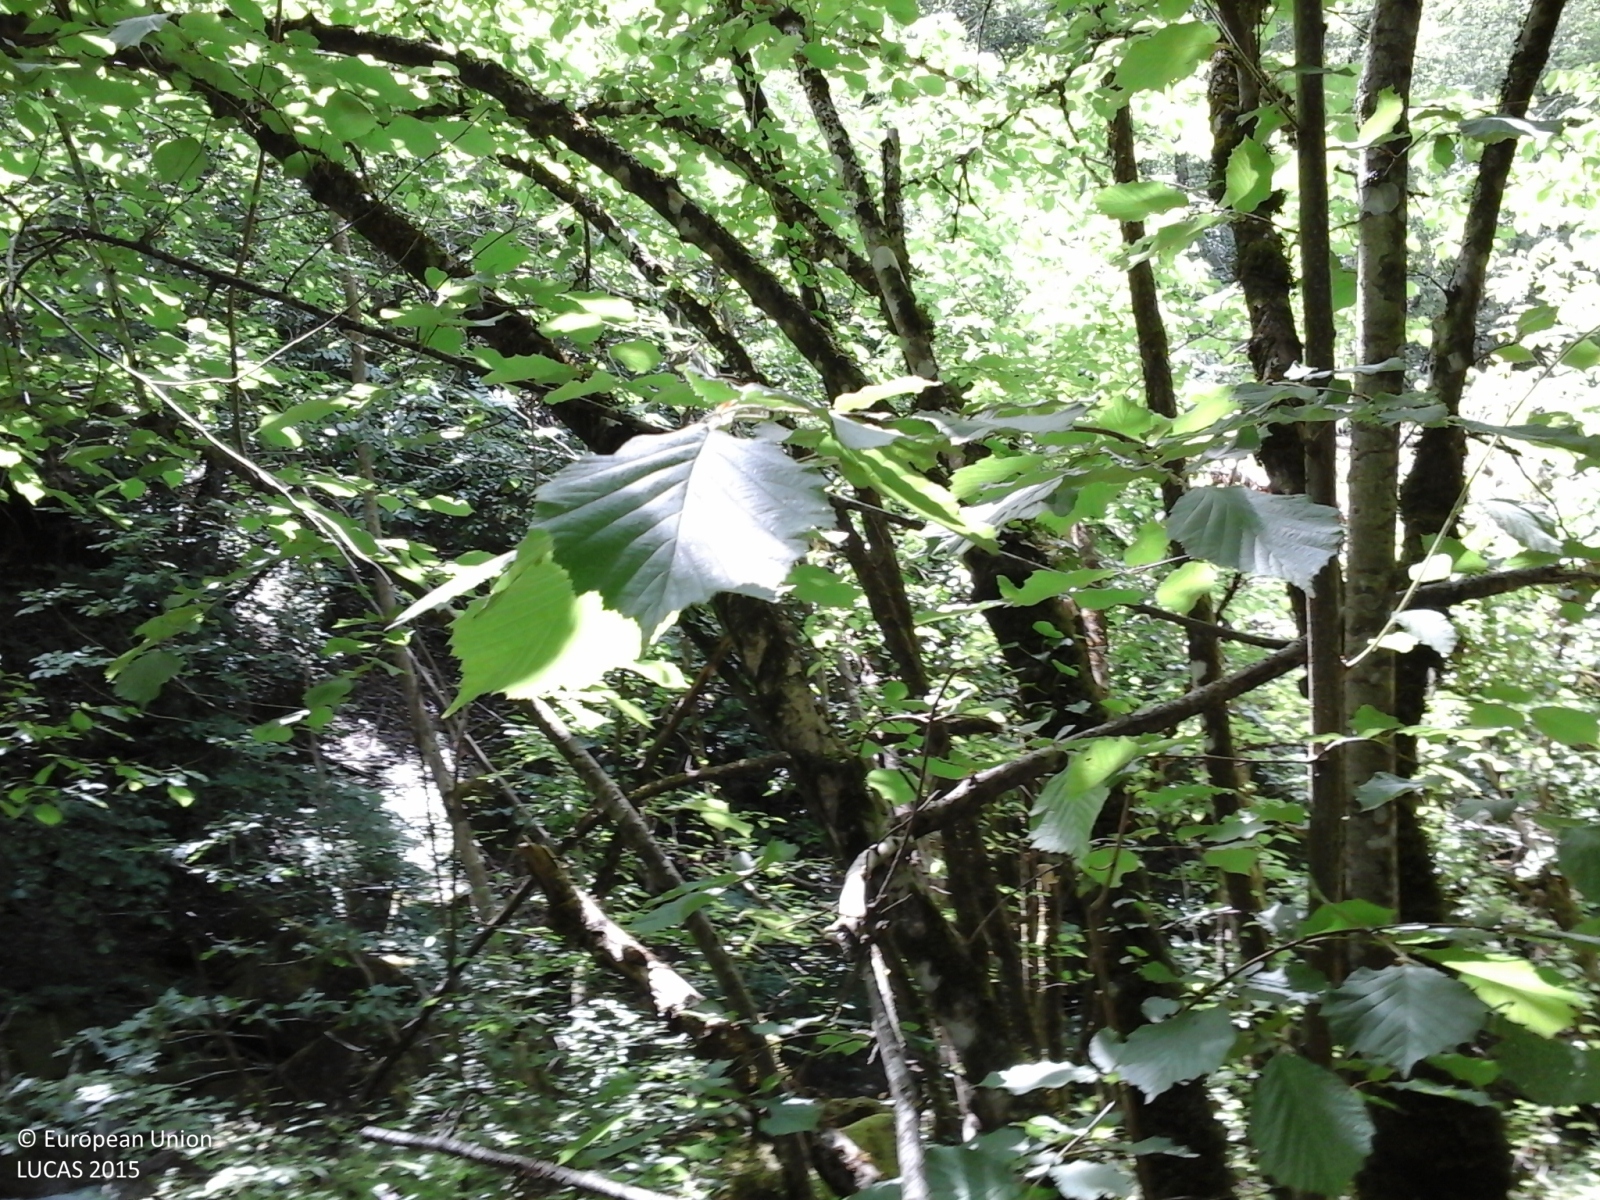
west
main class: Woodland
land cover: Broadleaved woodland
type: thermophilous deciduous forest
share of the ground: > 75 %
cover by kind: broadleaved forest trees 95 %, shrubs 5 %
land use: Semi-natural and natural areas not in use
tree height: > 5 m
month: June
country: IT
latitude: 43.8821
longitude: 11.8996
